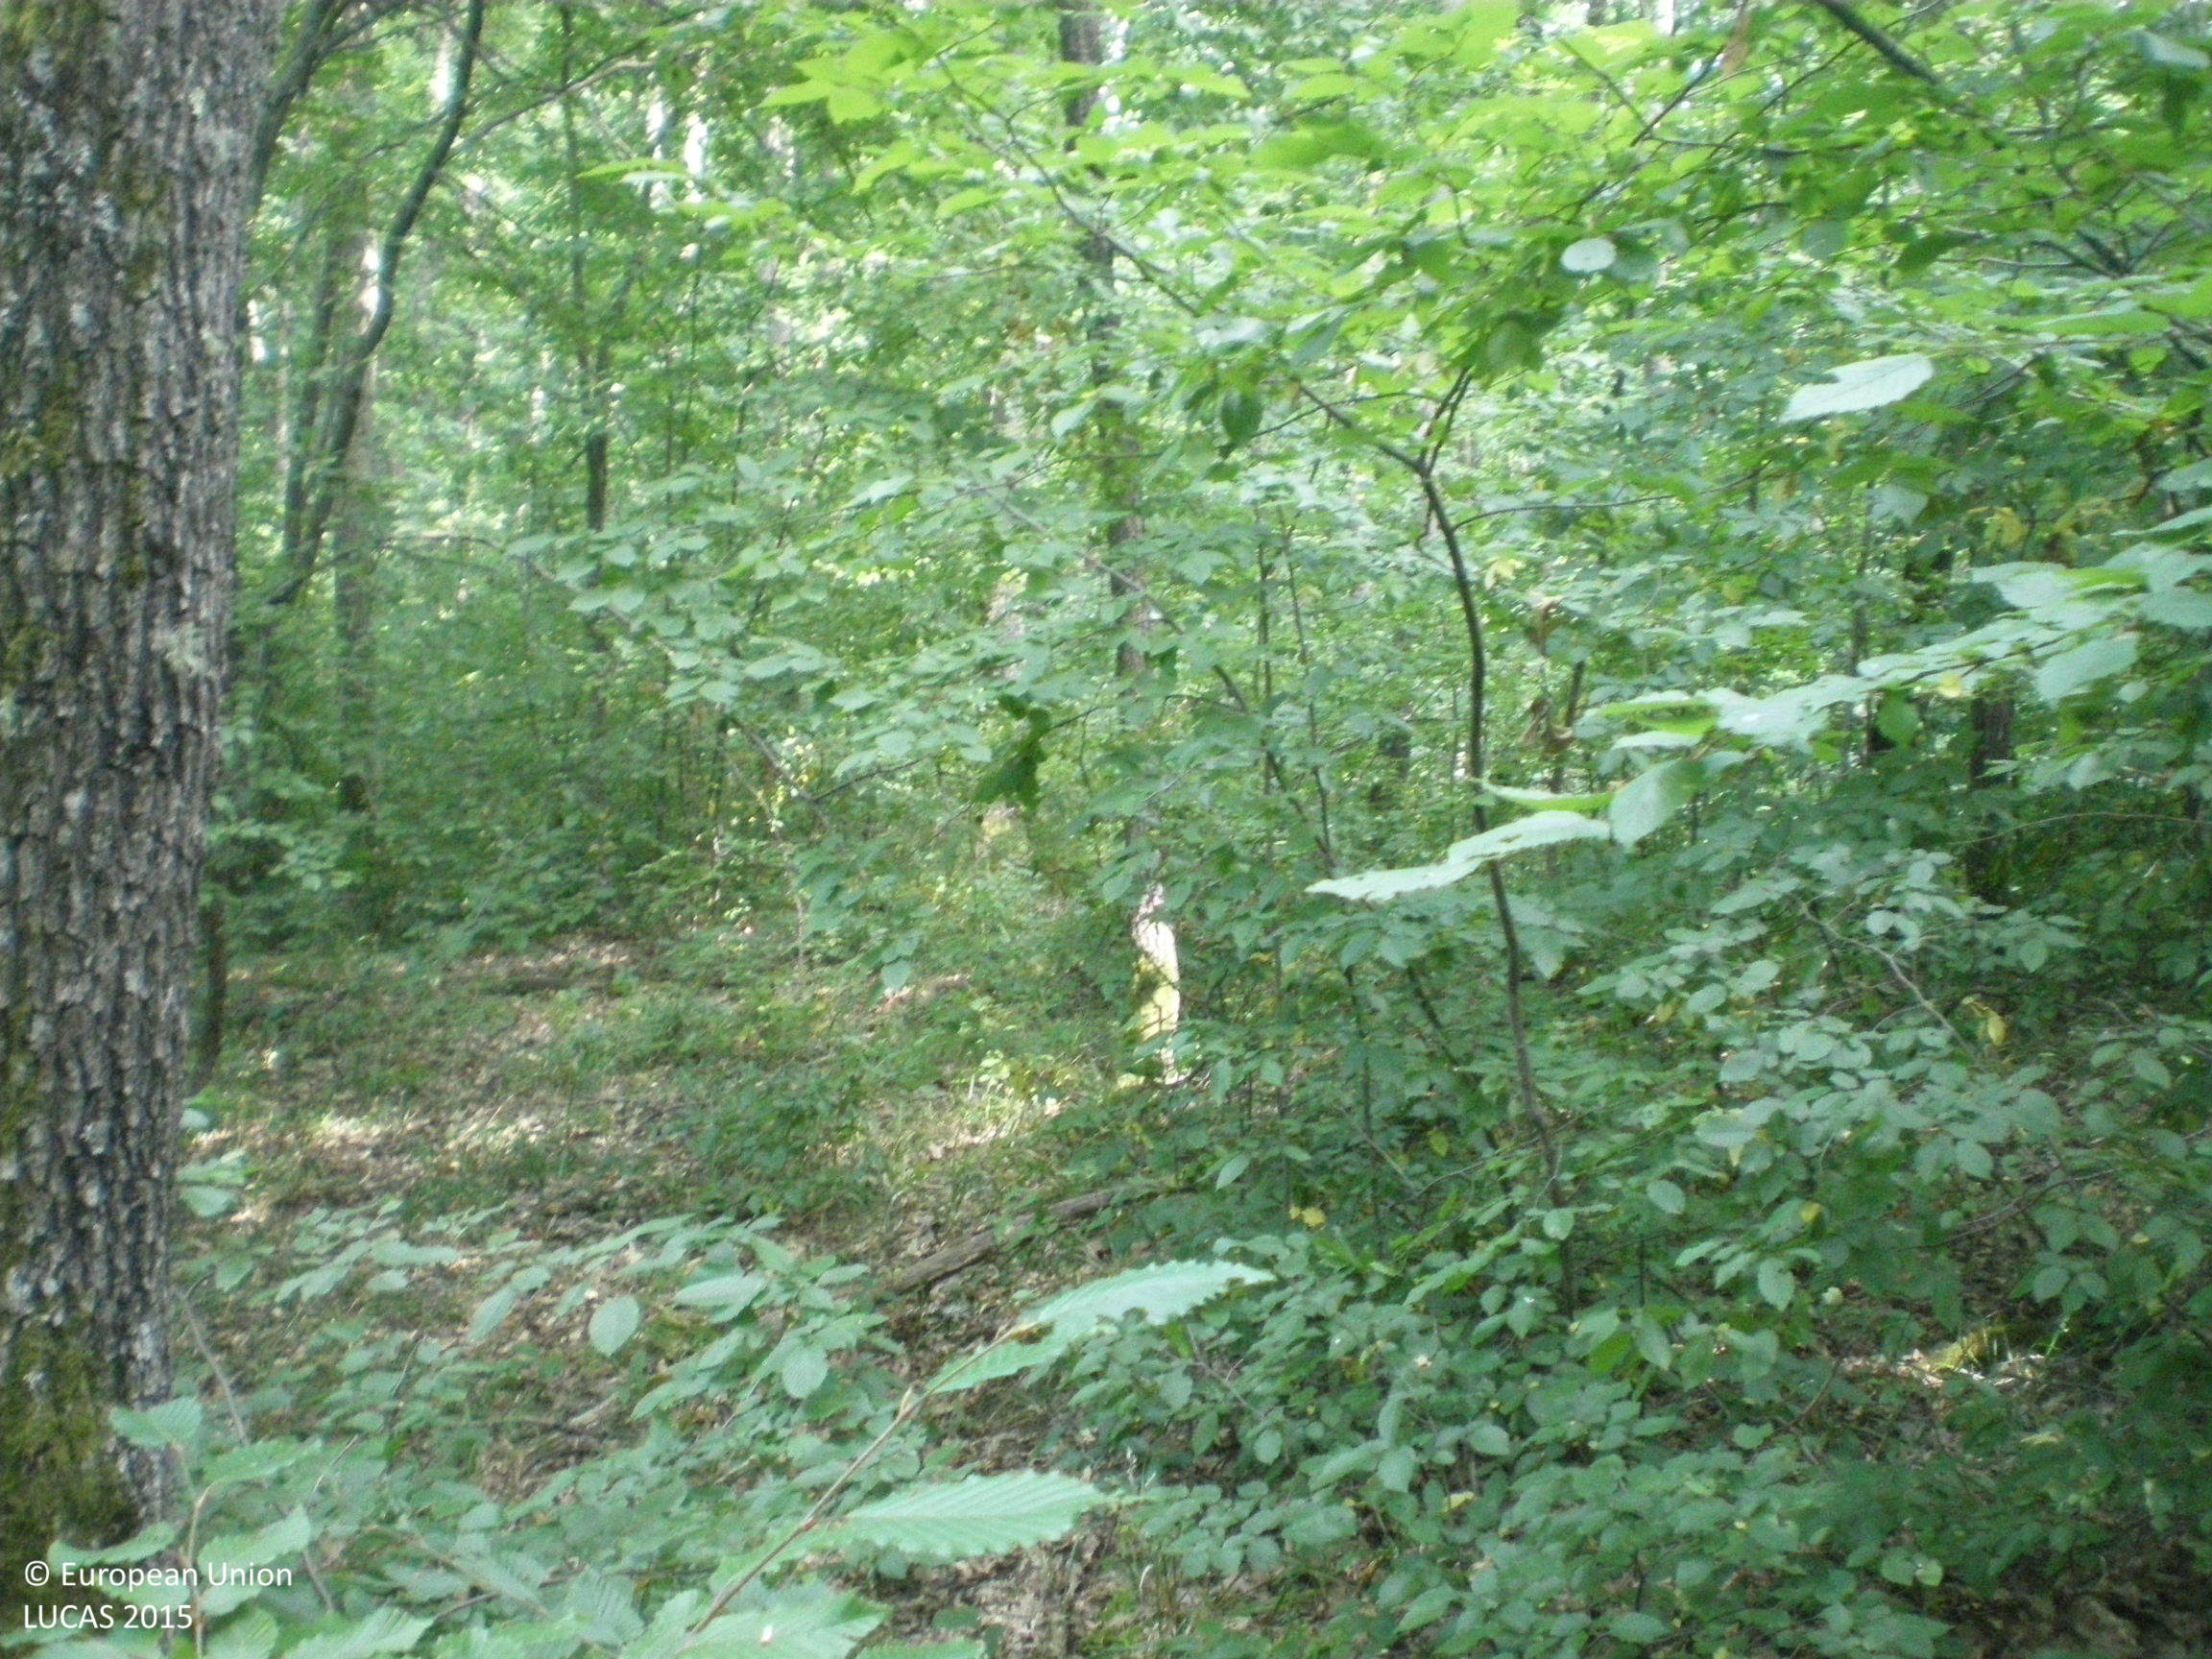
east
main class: Woodland
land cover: Broadleaved woodland
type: mesophytic deciduous forest
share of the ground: > 75 %
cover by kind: broadleaved forest trees 100 %
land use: Forestry
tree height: > 5 m
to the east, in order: Broadleaved woodland; Rivers and streams; Broadleaved woodland; Tracks; Broadleaved woodland
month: July
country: BG
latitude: 42.5517
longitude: 25.1530
